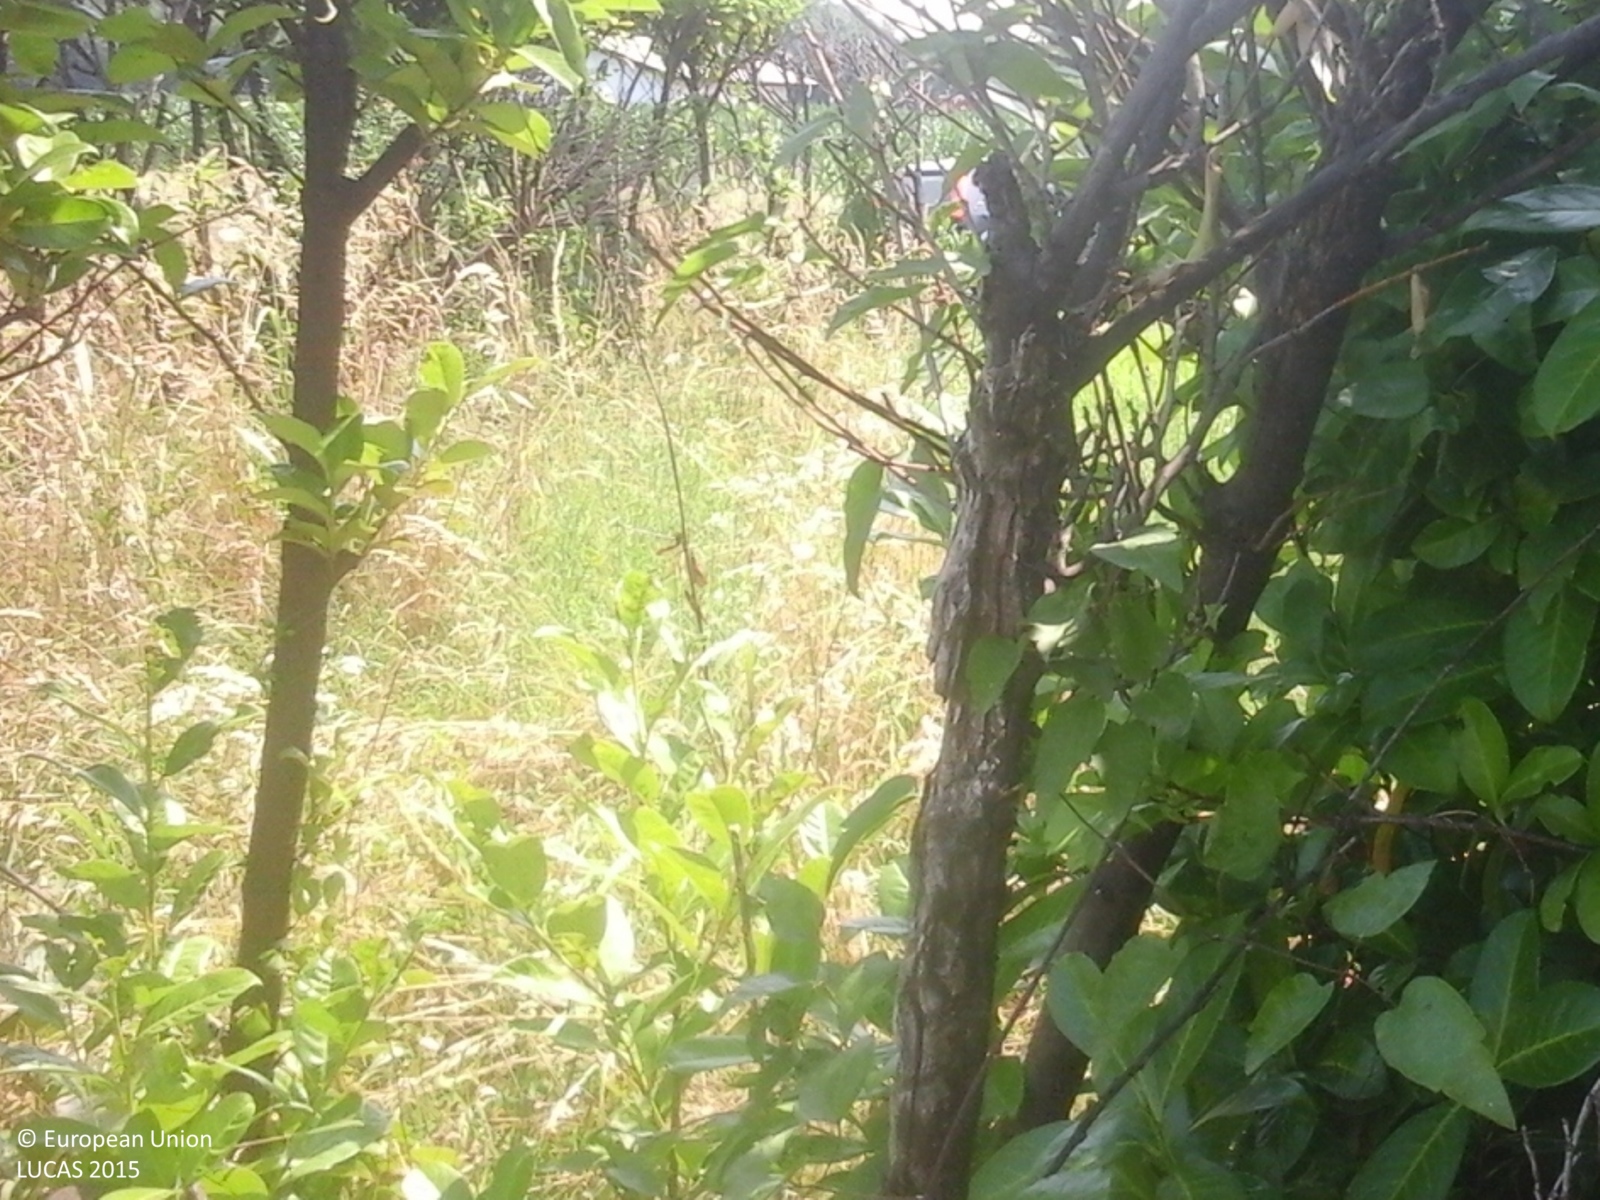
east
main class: Grassland
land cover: Grassland without tree/shrub cover
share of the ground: > 75 %
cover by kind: herbaceous plants 100 %
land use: Agriculture (excluding fallow land and kitchen gardens)
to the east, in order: Grassland without tree/shrub cover; Electric lines; Paved roads, cycling and walking lanes; Grassland without tree/shrub cover; Ditches and canals; Soya; Maize; Artificial constructions in urban areas; Maize; Artificial constructions in urban areas; Grassland without tree/shrub cover; Soya; Electric lines; Soya; Spontaneously vegetated surfaces; Soya
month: July
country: IT
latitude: 45.6470
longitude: 9.4236
